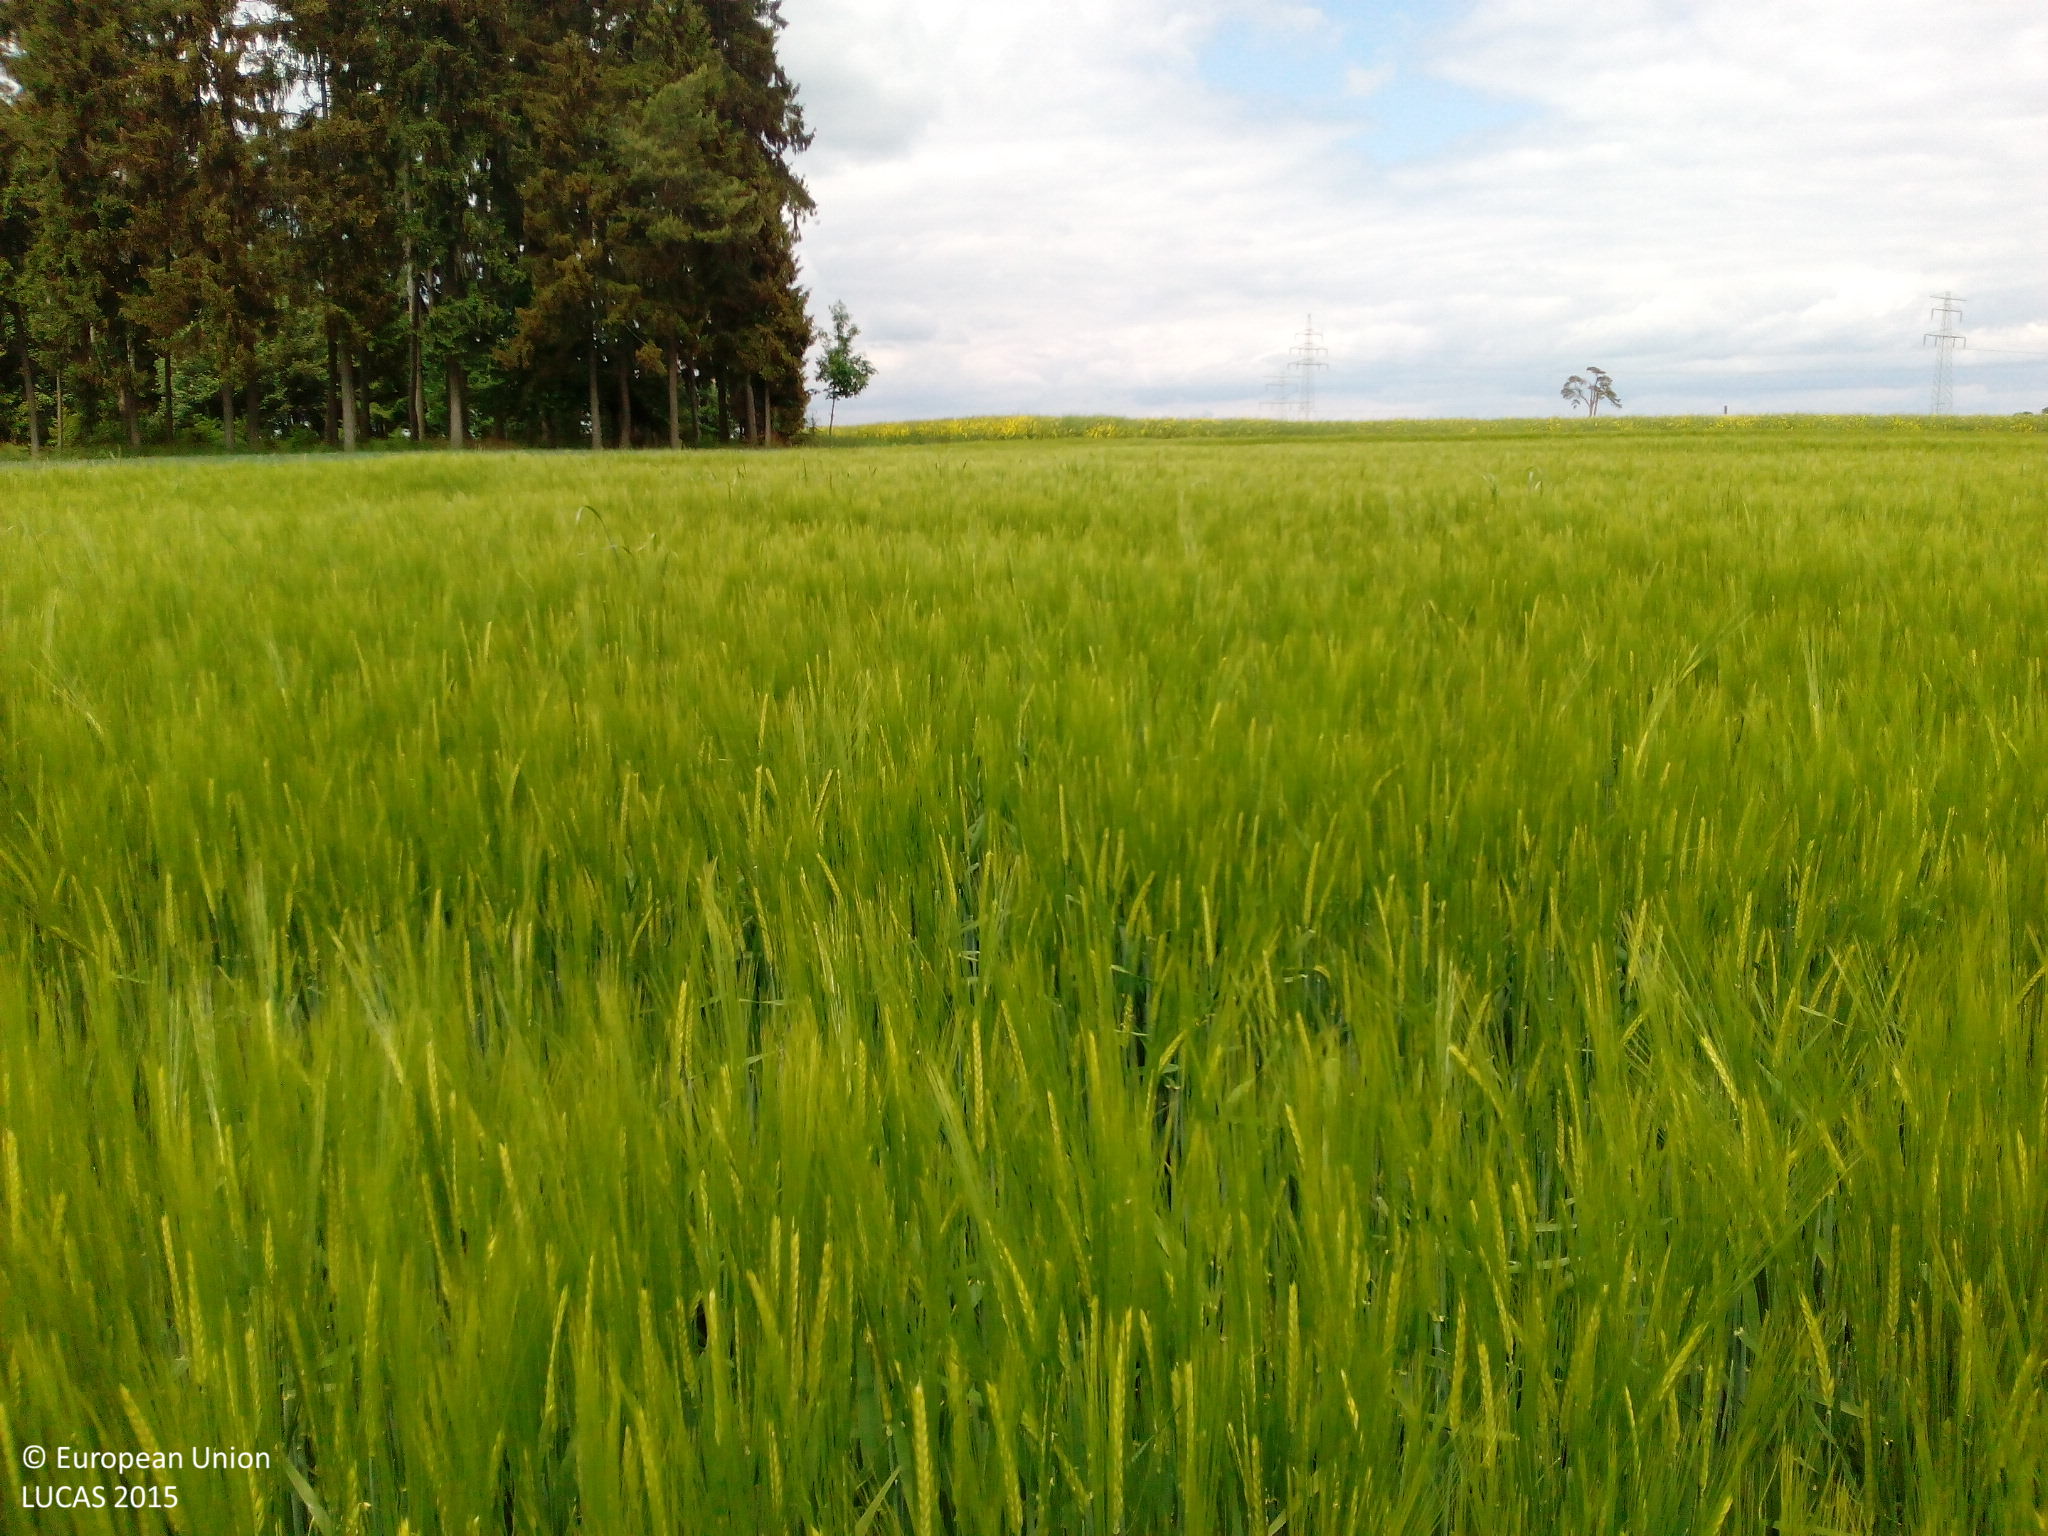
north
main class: Cropland
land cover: Barley
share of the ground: > 75 %
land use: Agriculture (excluding fallow land and kitchen gardens)
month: May
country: DE
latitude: 49.0952
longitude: 11.4922
